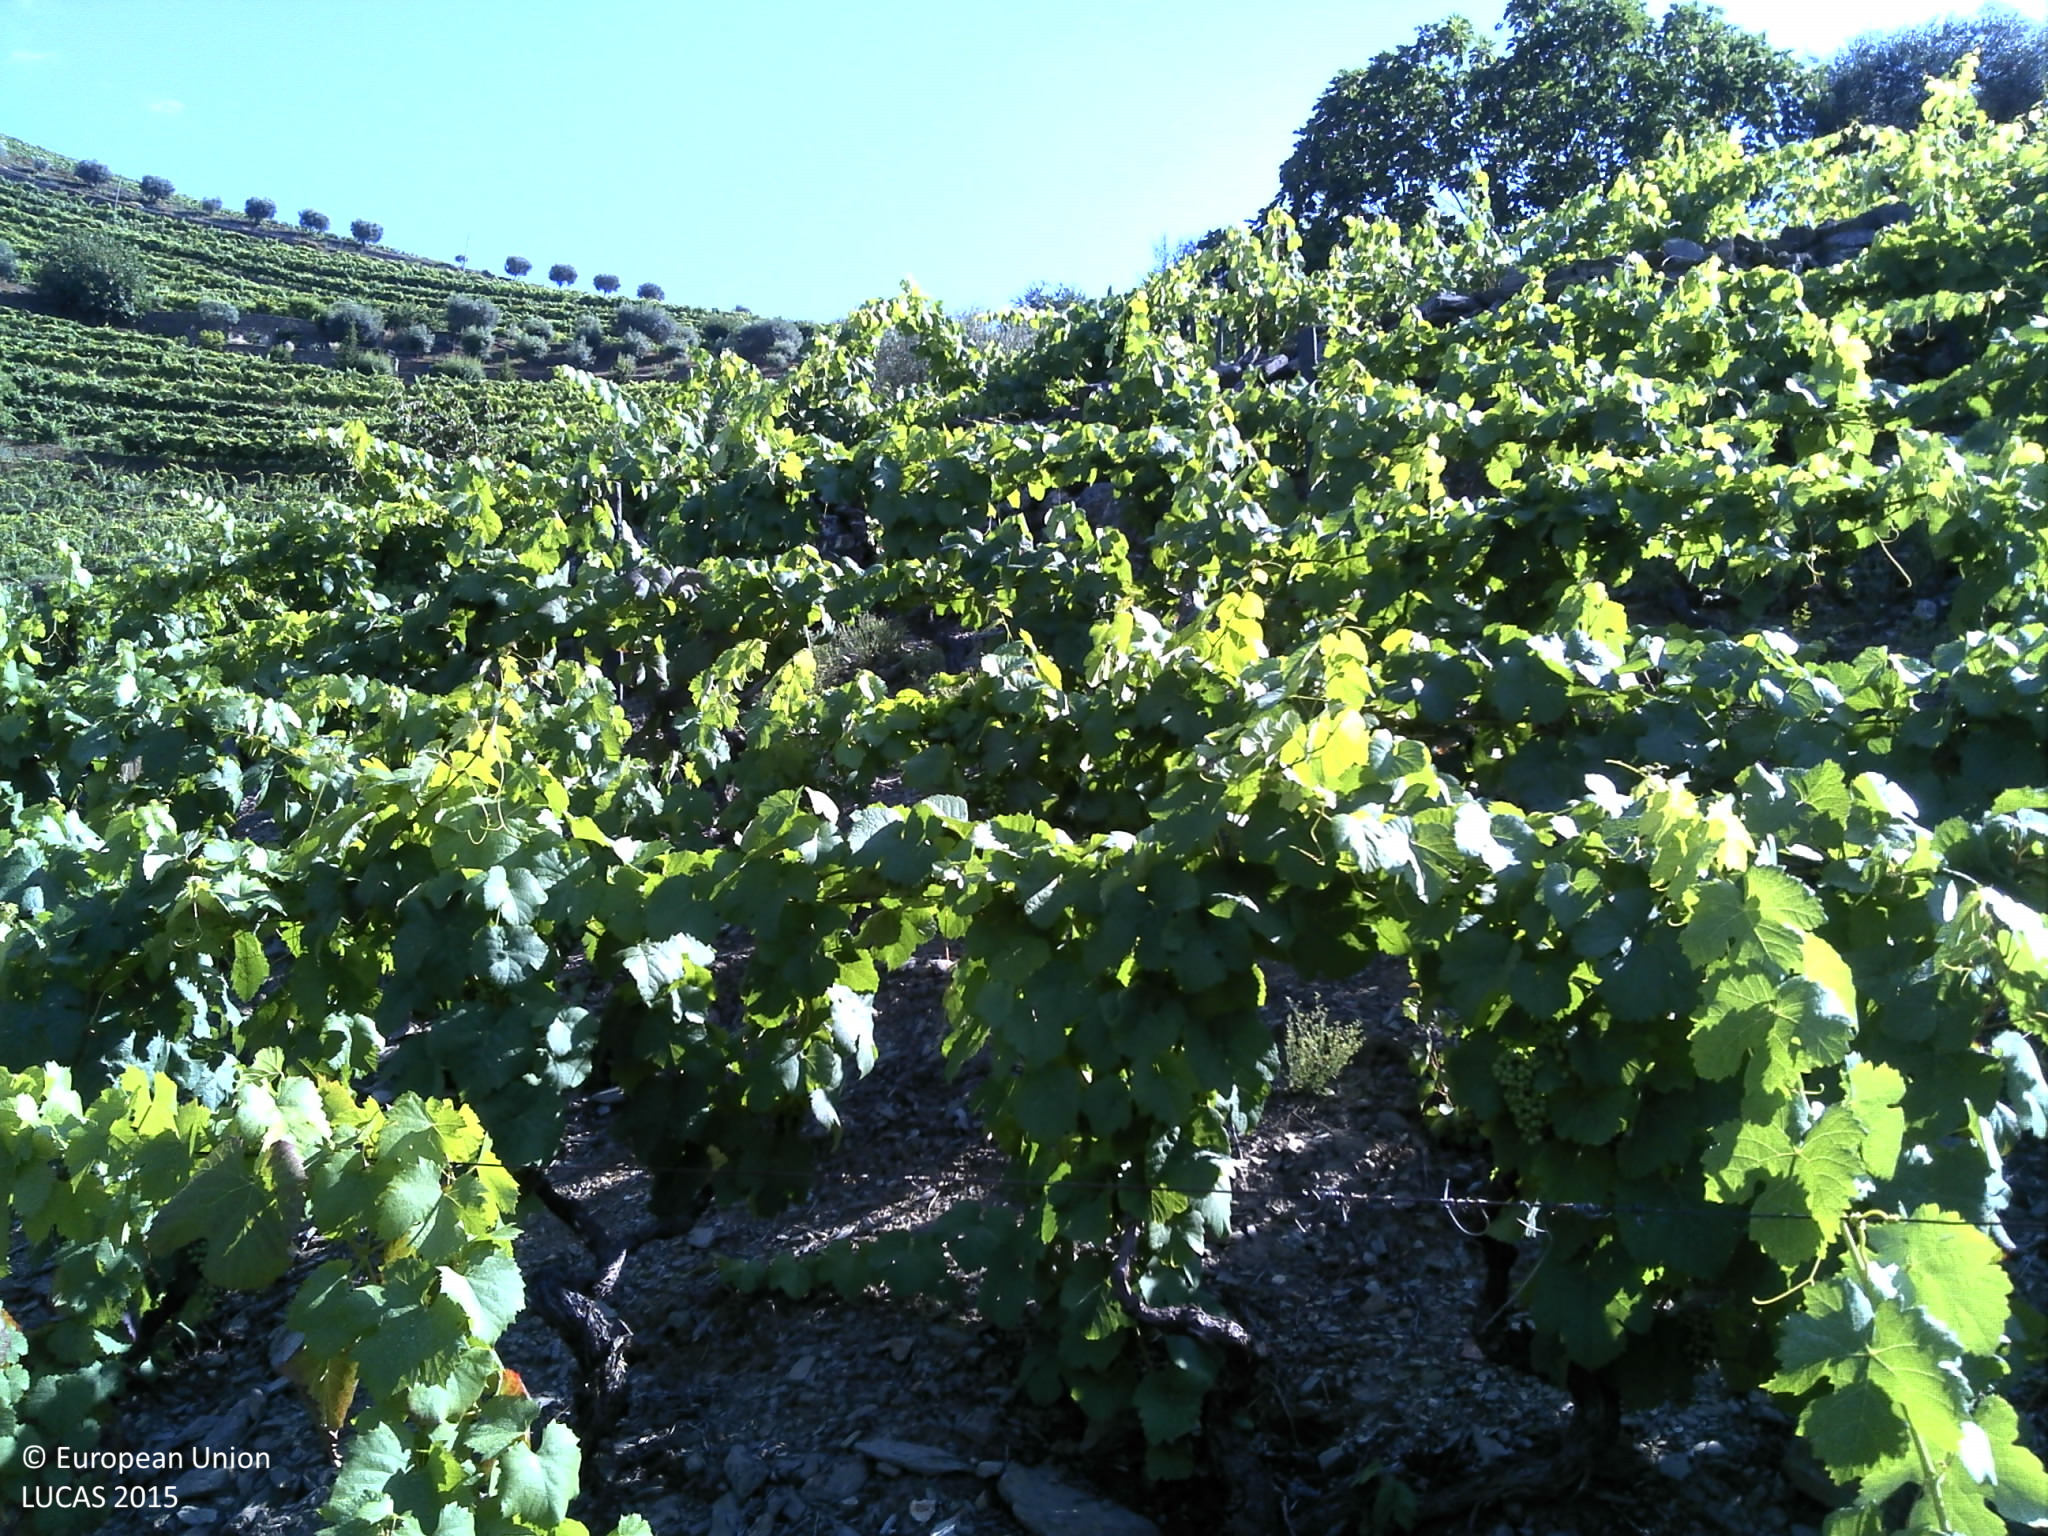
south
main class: Cropland
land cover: Vineyards
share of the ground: 10 - 25 %
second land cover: Other bare soil
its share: > 75 %
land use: Agriculture (excluding fallow land and kitchen gardens)
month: June
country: PT
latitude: 41.1403
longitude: -7.6751
